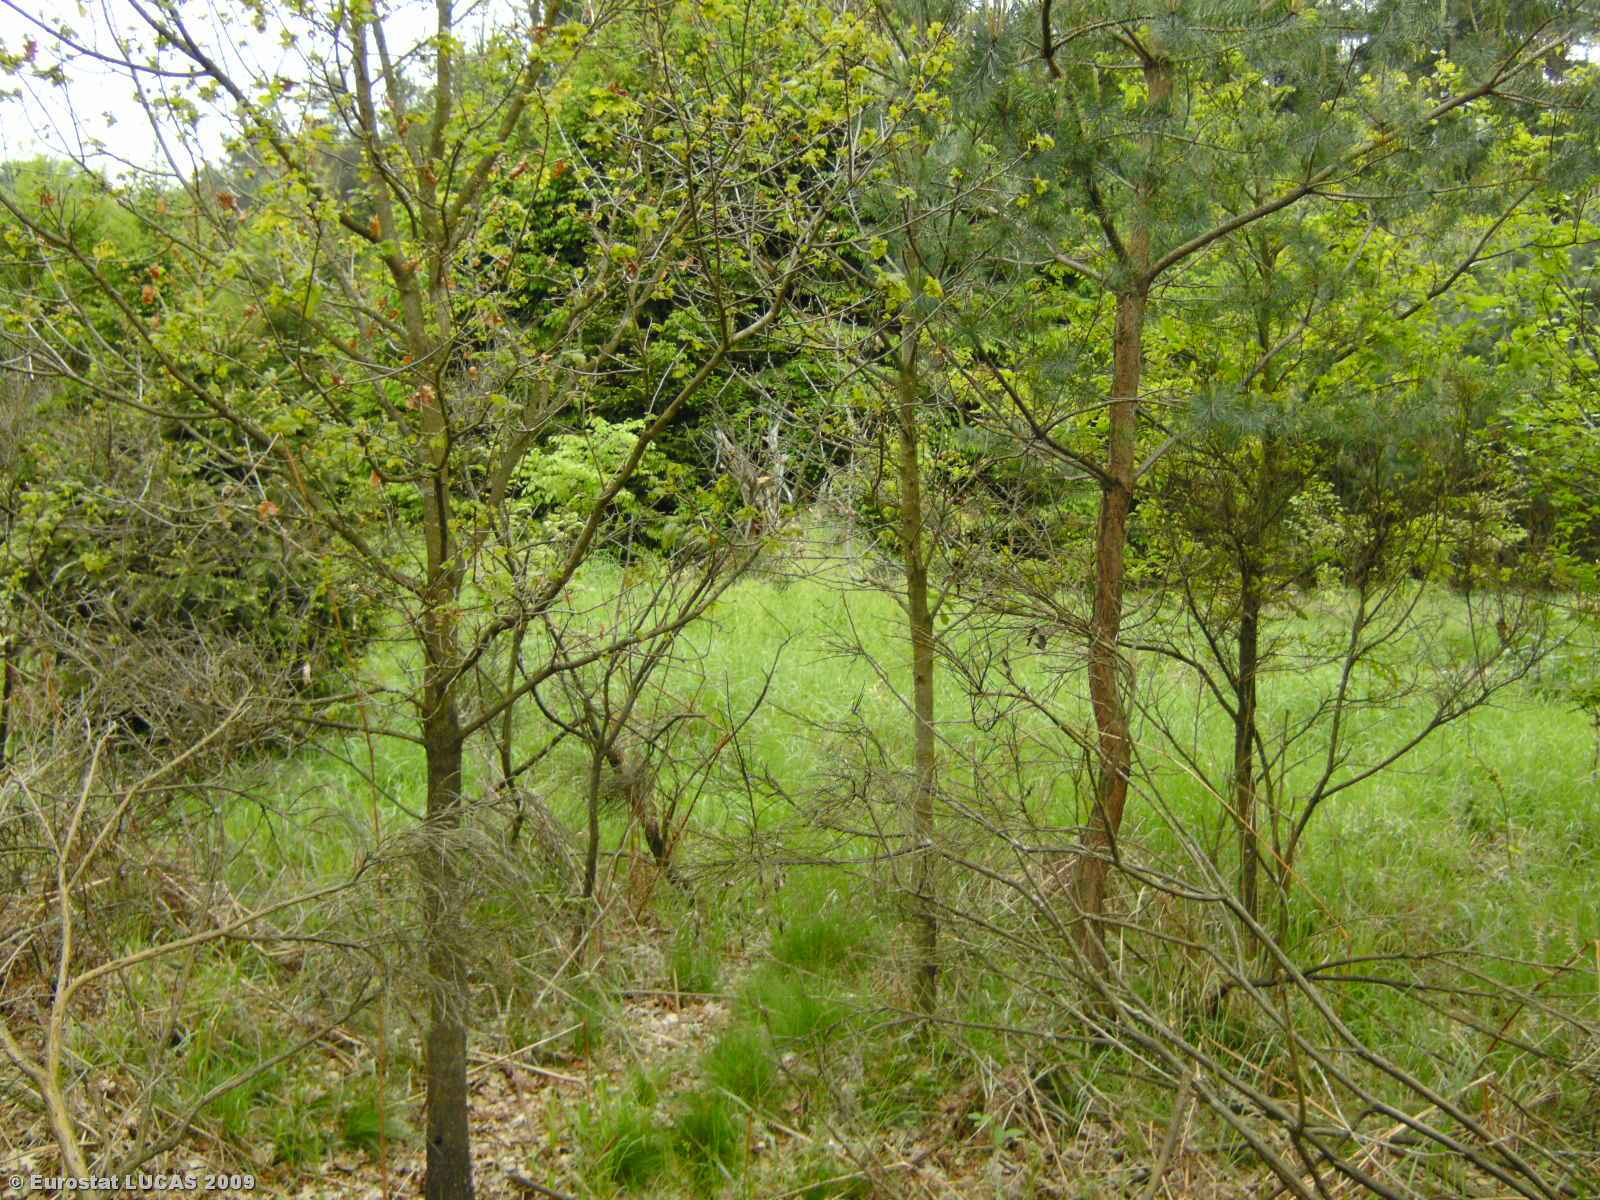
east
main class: Woodland
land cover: Broadleaved woodland
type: hemiboreal forest and nemoral coniferous forest and mixed broadleaved-coniferous forest
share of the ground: 50 - 75 %
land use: Forestry
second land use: Amenities, museums, leisure
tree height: > 5 m
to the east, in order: Broadleaved woodland; Tracks; Broadleaved woodland; Grassland with sparse tree/shrub cover; Coniferous woodland; Grassland without tree/shrub cover; Broadleaved woodland; Tracks; Coniferous woodland; Mixed woodland
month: May
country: LU
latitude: 49.6894
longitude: 6.2152
